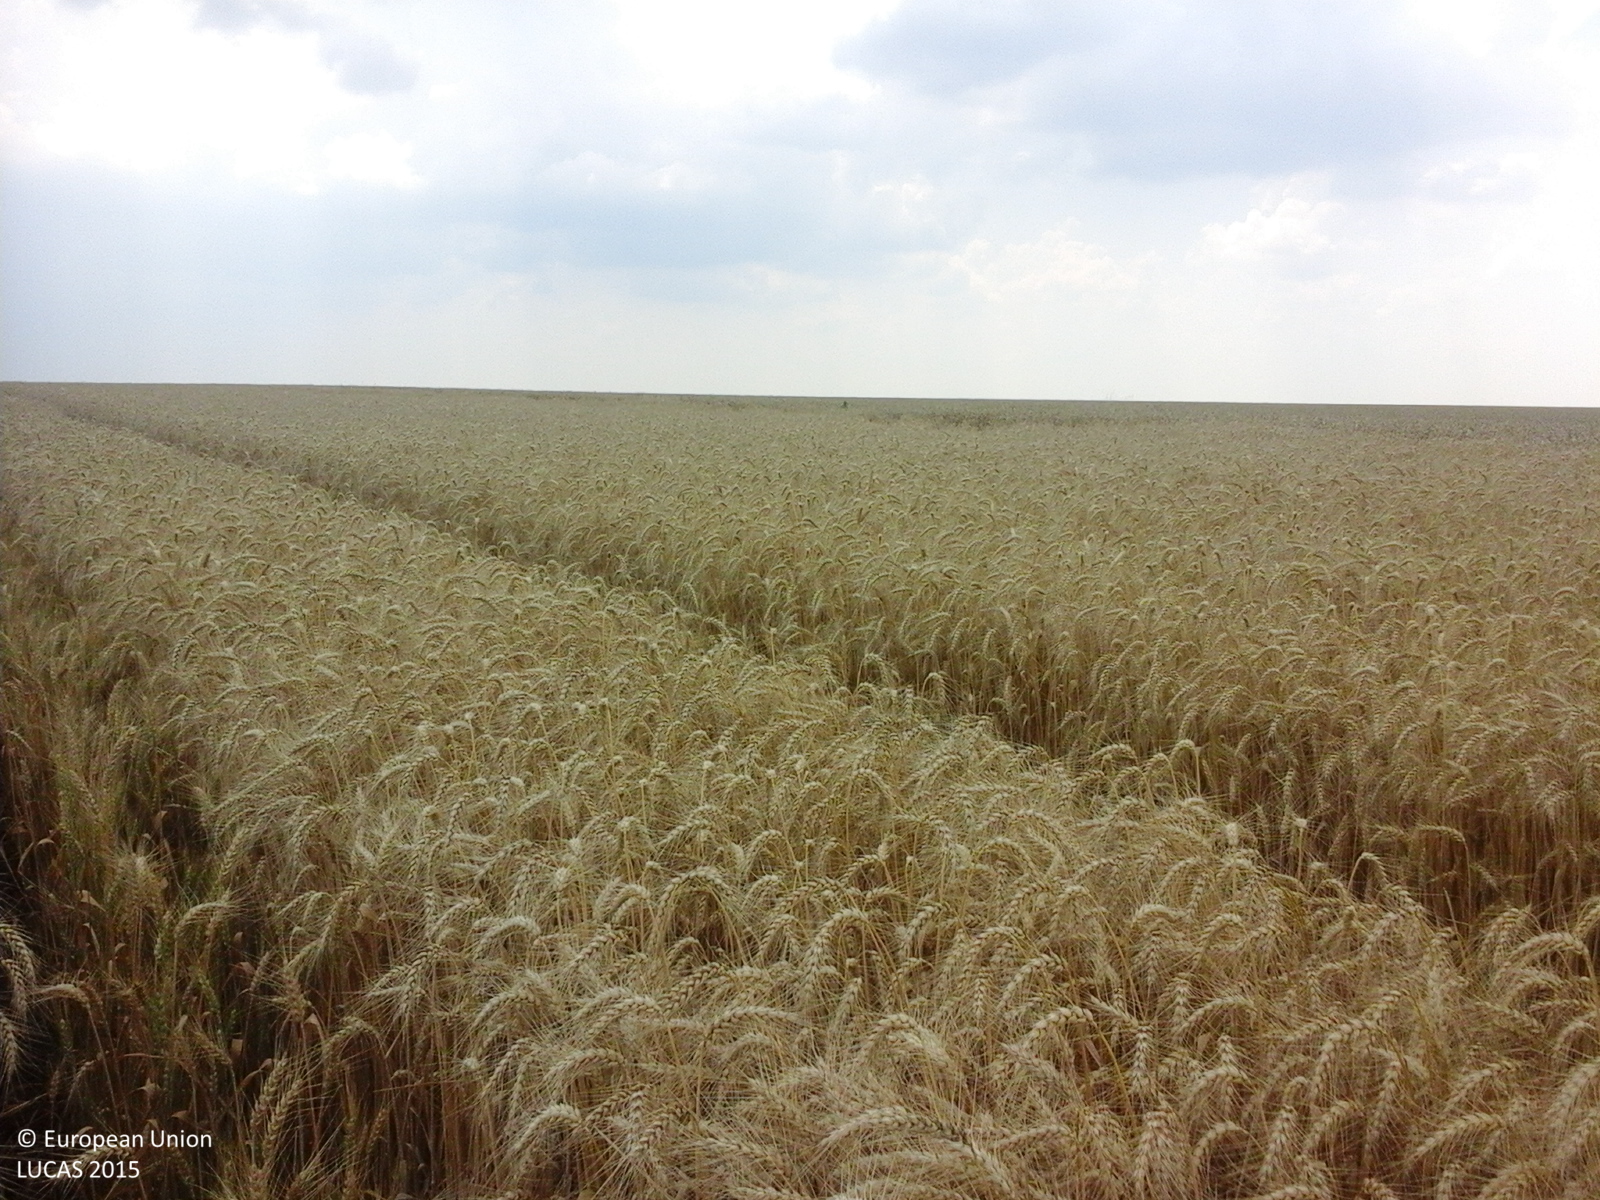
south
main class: Cropland
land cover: Common wheat
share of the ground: > 75 %
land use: Agriculture (excluding fallow land and kitchen gardens)
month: July
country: RO
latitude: 43.9427
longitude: 25.1669
